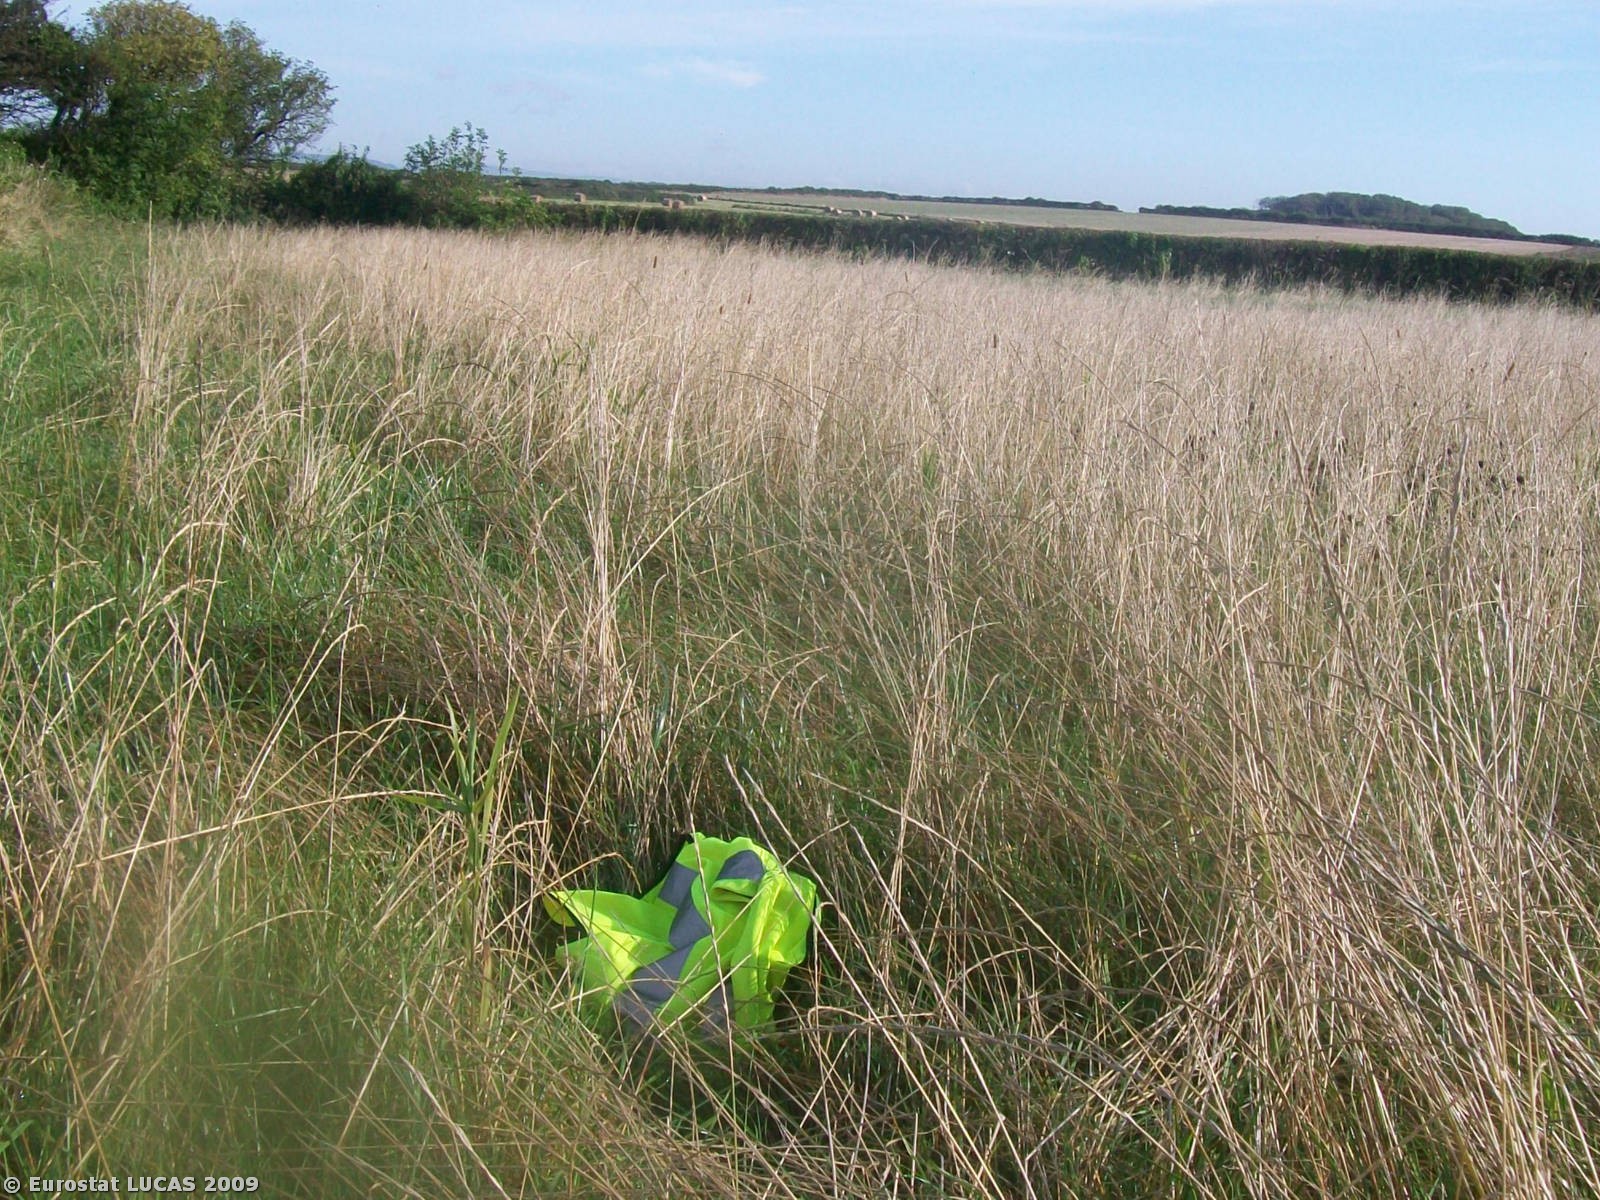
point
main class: Grassland
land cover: Grassland without tree/shrub cover
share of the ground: > 75 %
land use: Agriculture (excluding fallow land and kitchen gardens)
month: September
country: GB
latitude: 51.4334
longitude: -3.5346
